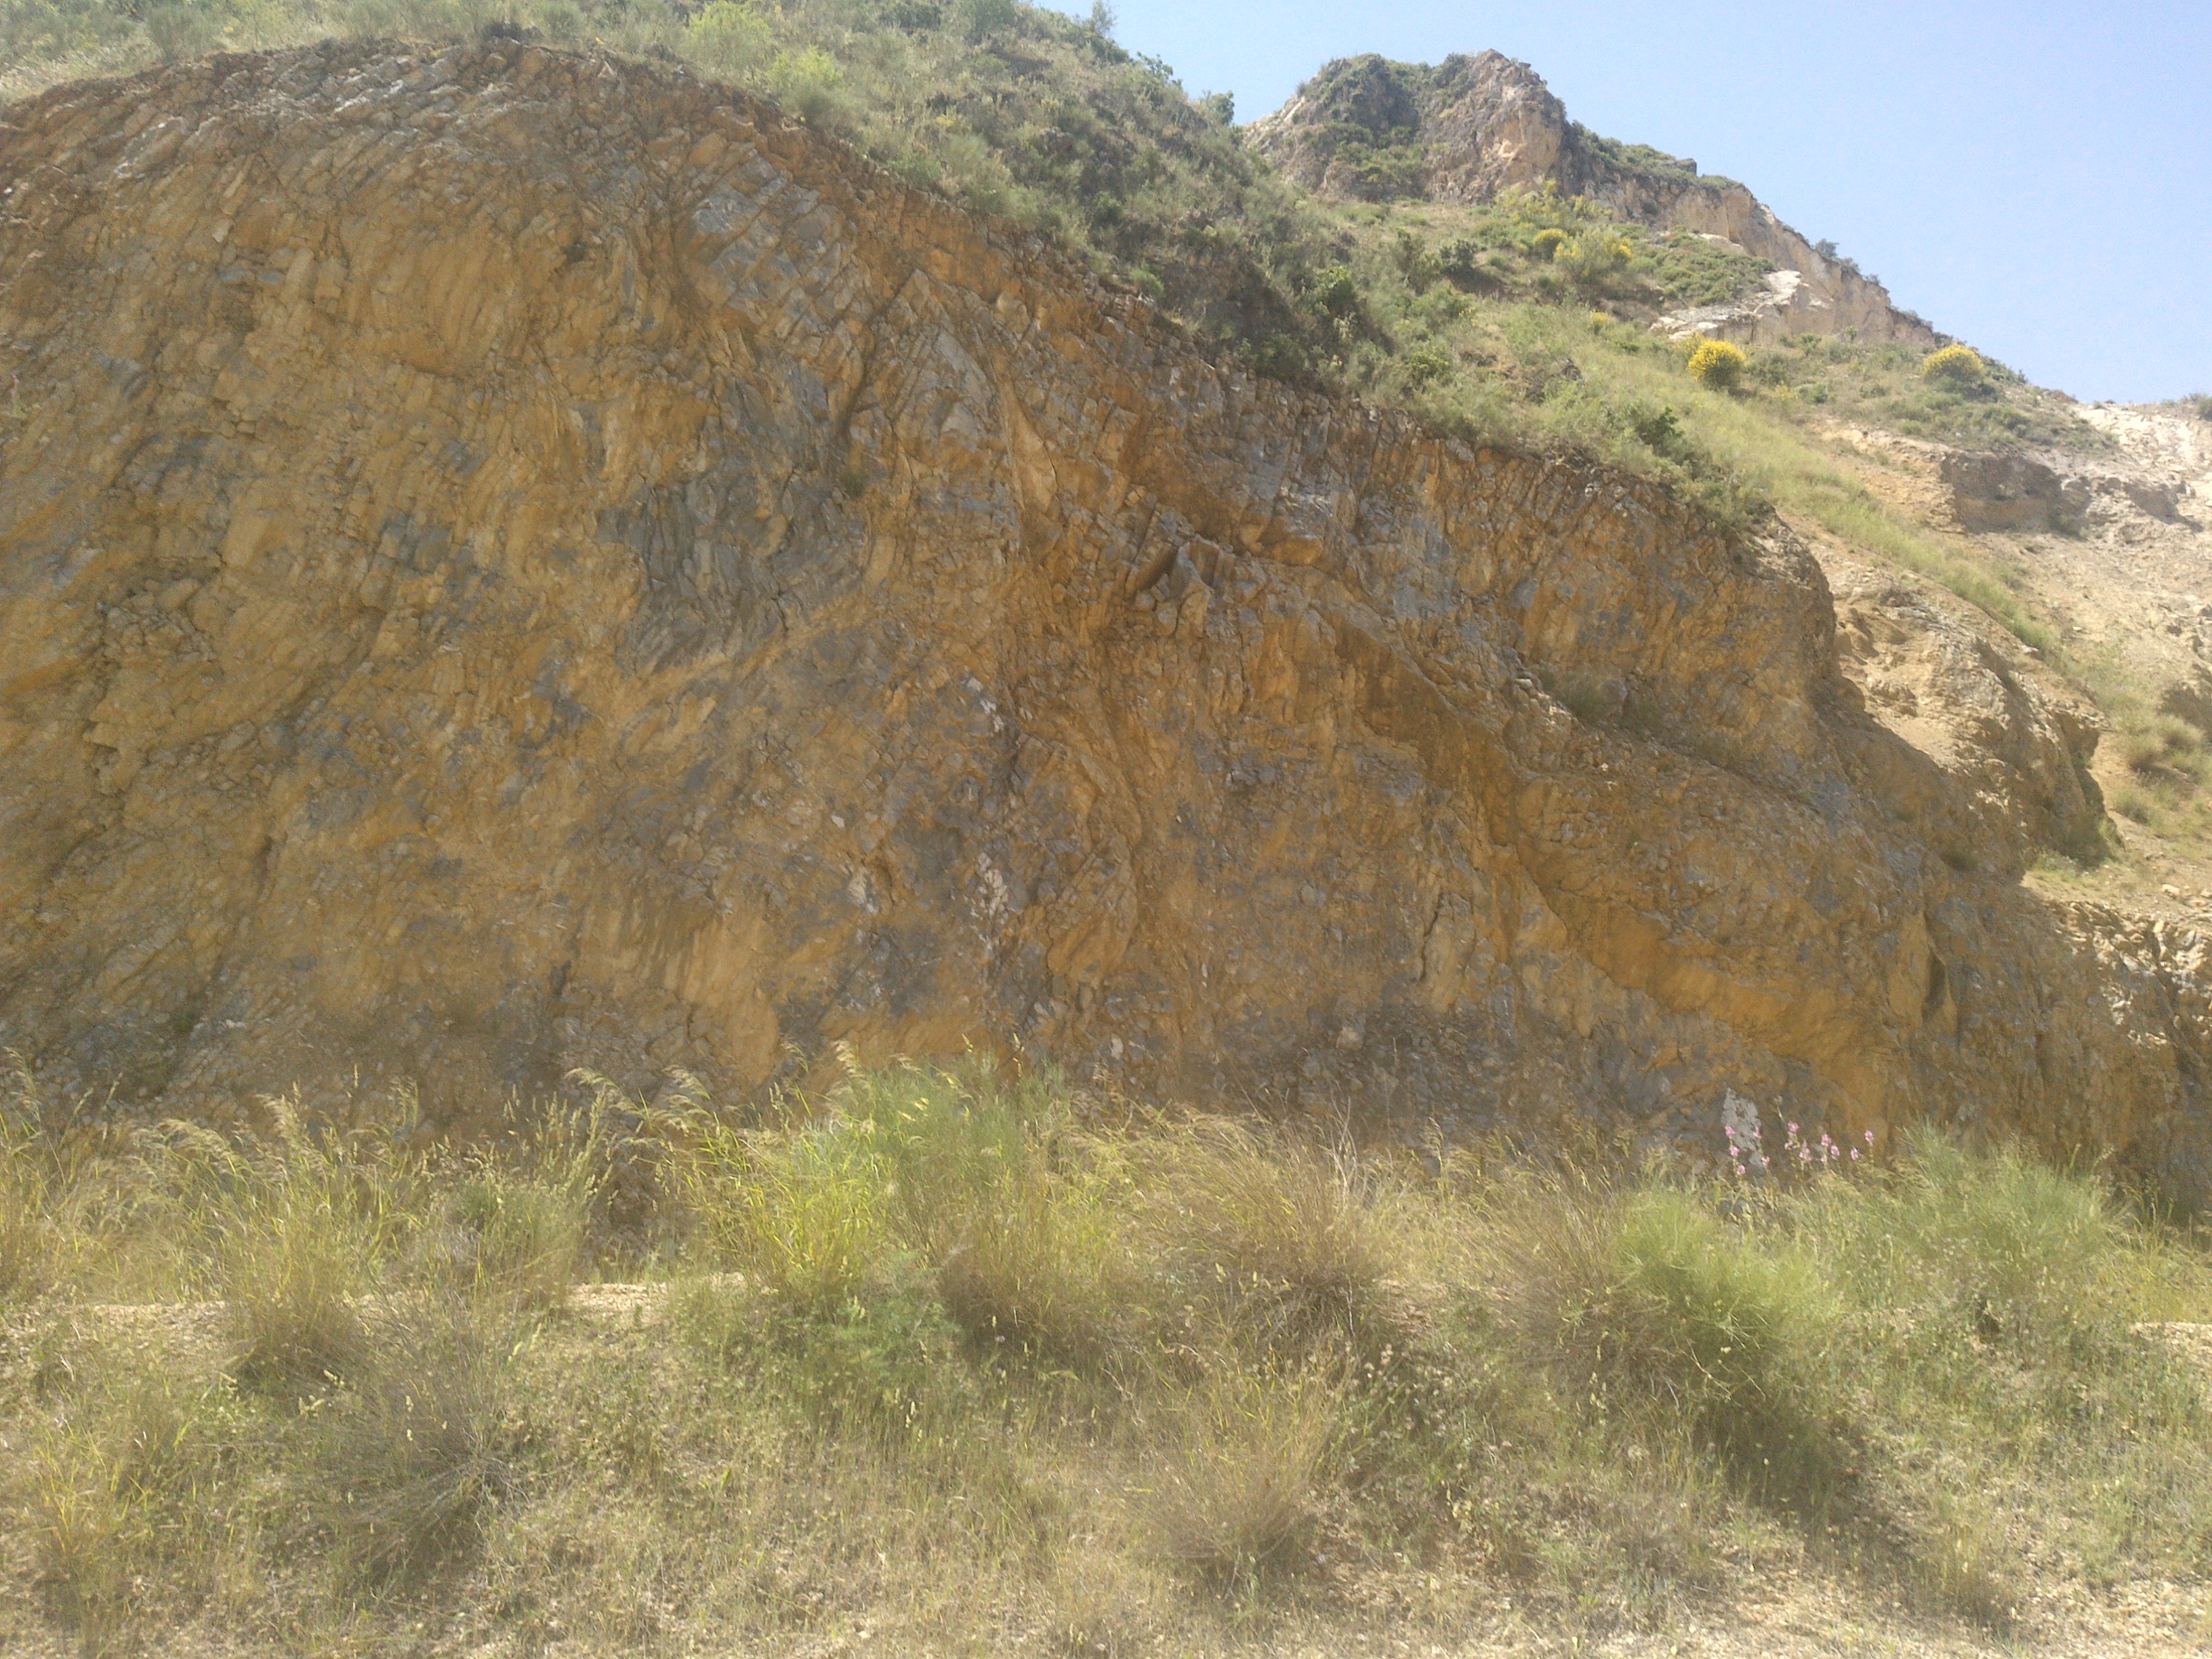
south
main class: Shrubland
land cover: Shrubland without tree cover
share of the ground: 25 - 50 %
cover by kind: herbaceous plants 70 %, shrubs 25 %, unconsolidated bare surface 5 %
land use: Semi-natural and natural areas not in use
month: May
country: ES
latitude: 37.4111
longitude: -4.2011
